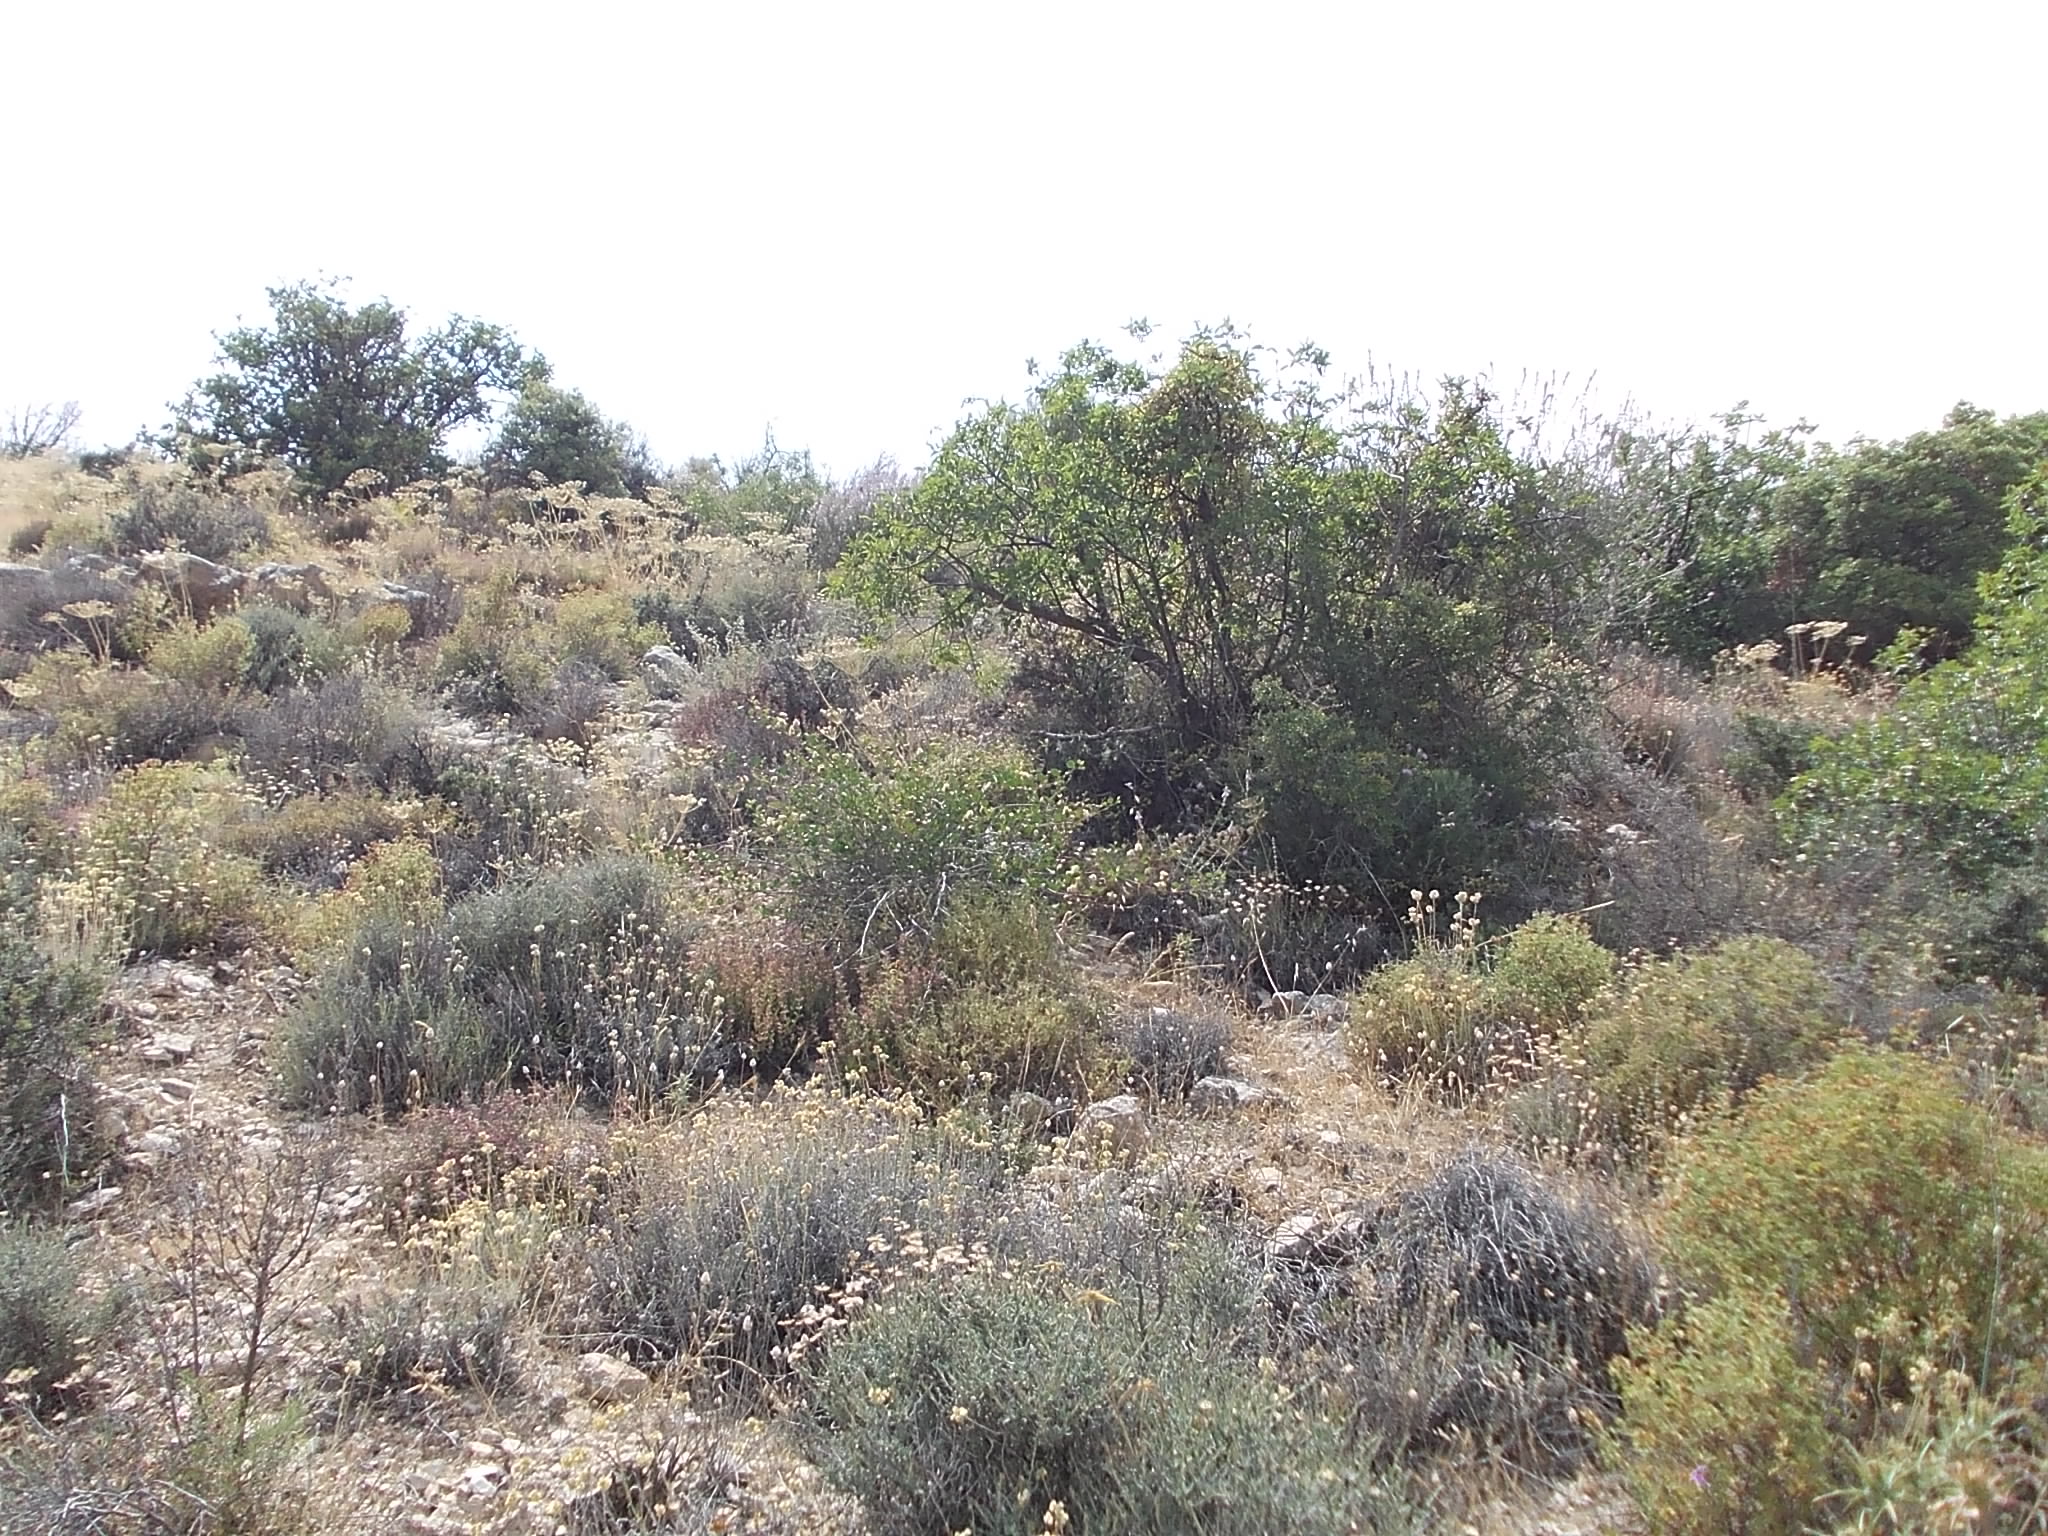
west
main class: Shrubland
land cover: Shrubland with sparse tree cover
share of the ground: 50 - 75 %
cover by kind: shrubs 55 %, unconsolidated bare surface 25 %, herbaceous plants 15 %, broadleaved forest trees 5 %
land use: Semi-natural and natural areas not in use
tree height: < 5 m
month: June
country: CY
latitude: 34.8104
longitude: 32.9355
